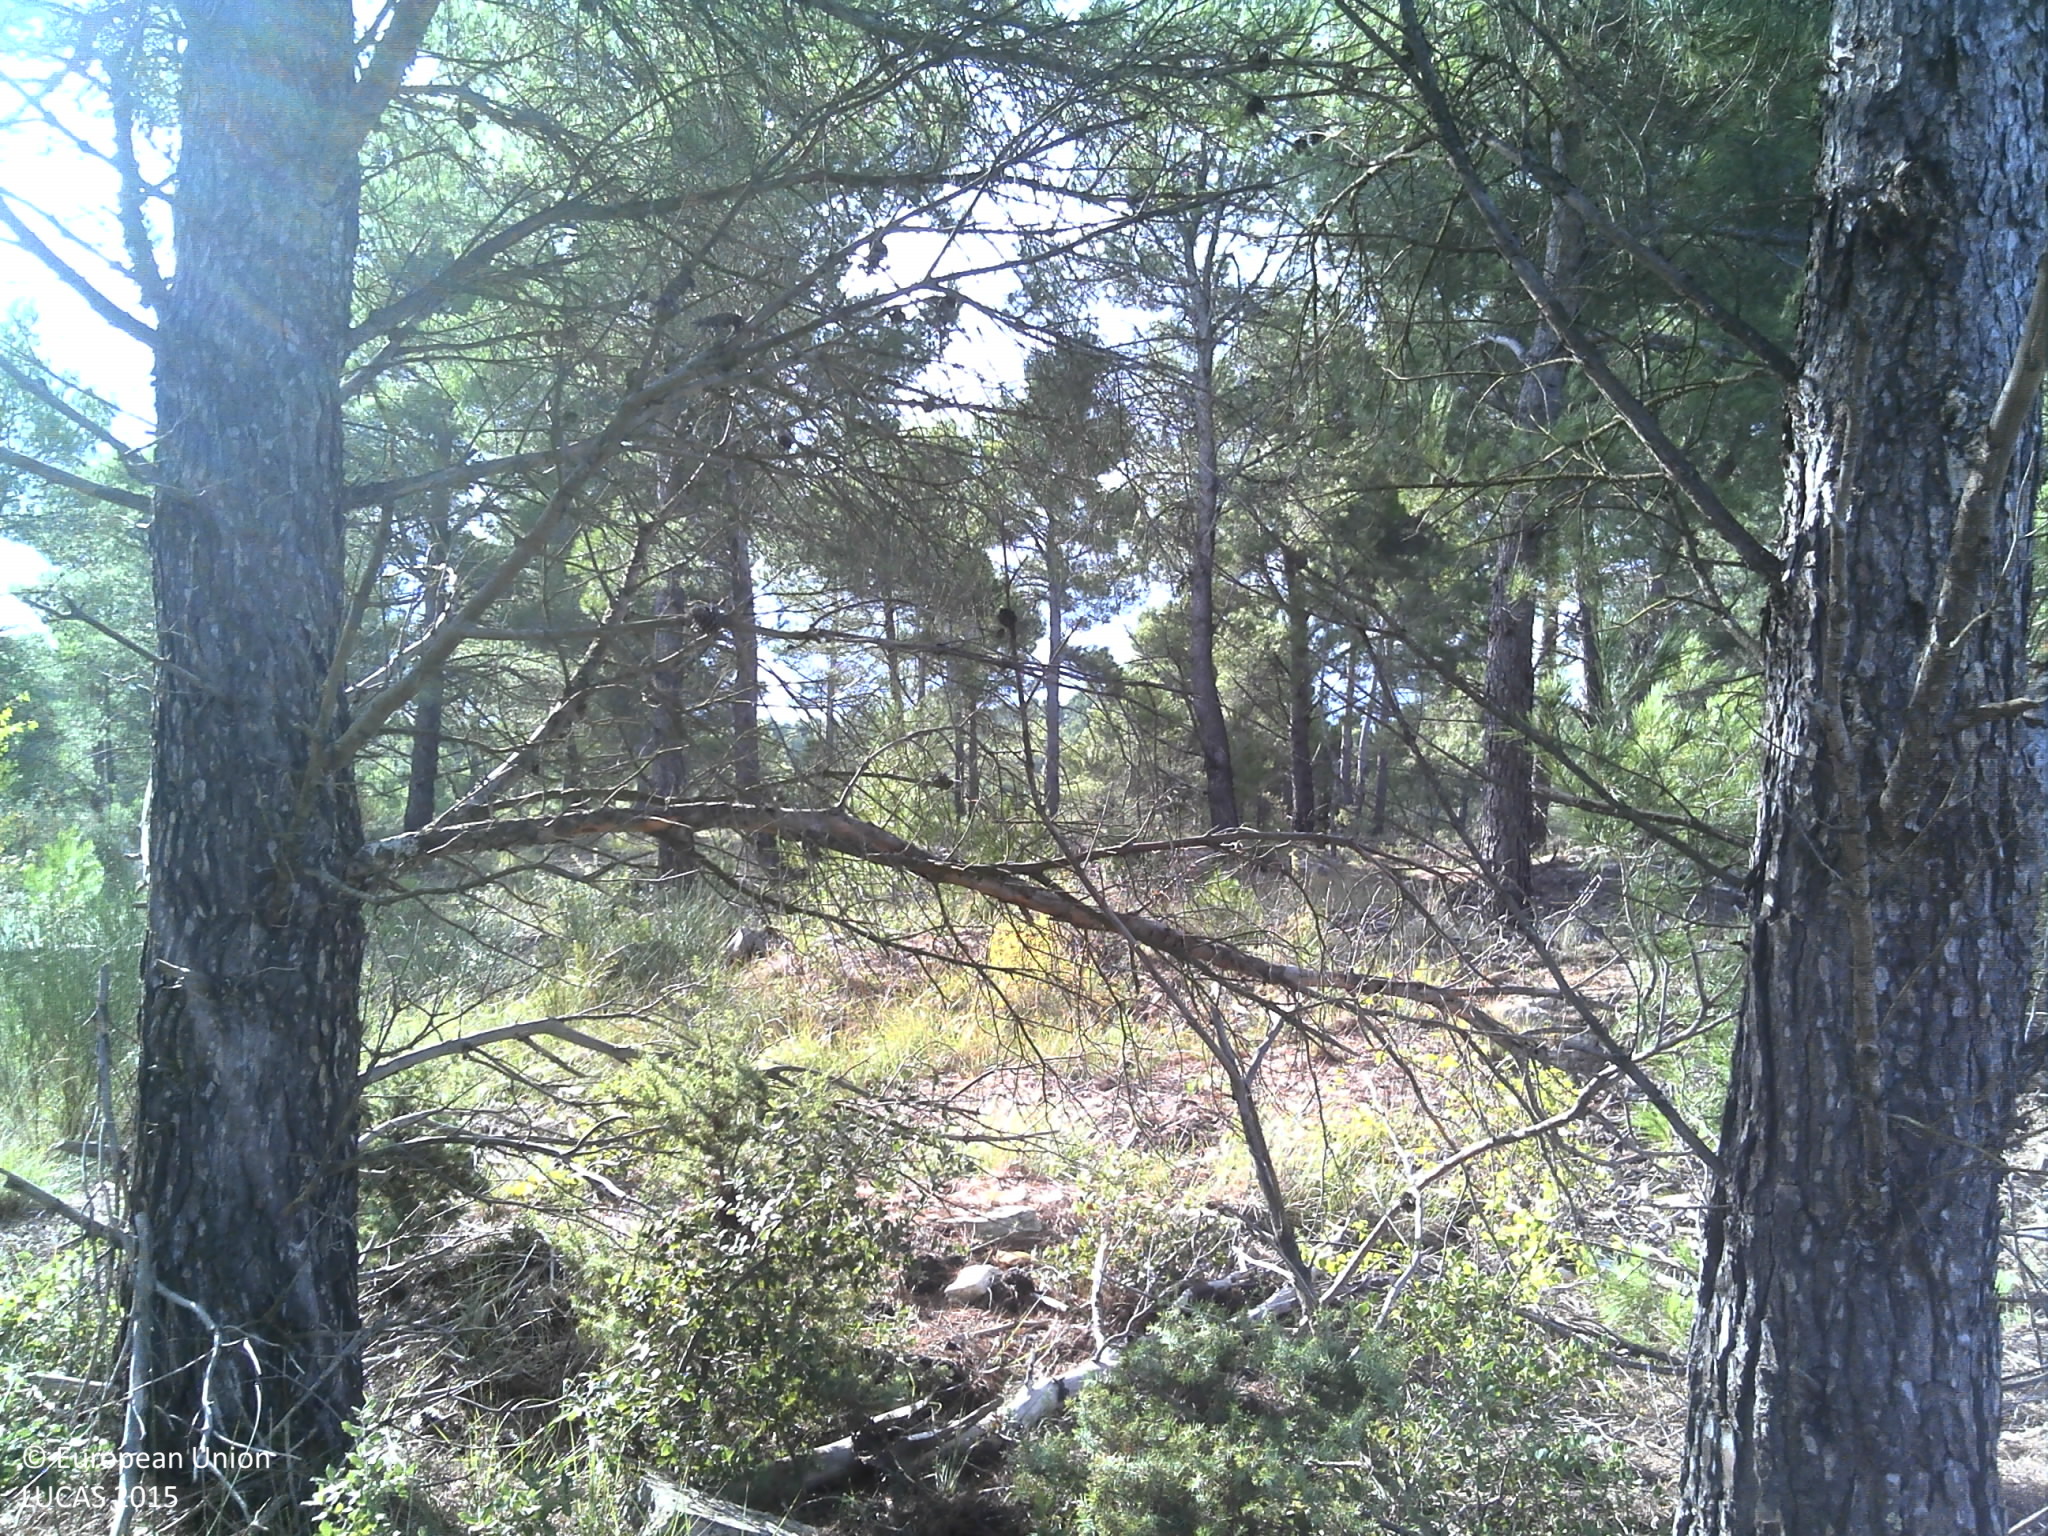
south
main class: Woodland
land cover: Pine dominated mixed woodland
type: coniferous forest of the mediterranean region
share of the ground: 50 - 75 %
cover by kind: coniferous forest trees 40 %, herbaceous plants 35 %, broadleaved forest trees 25 %
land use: Forestry
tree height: > 5 m
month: October
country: FR
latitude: 43.9631
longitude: 5.0856
